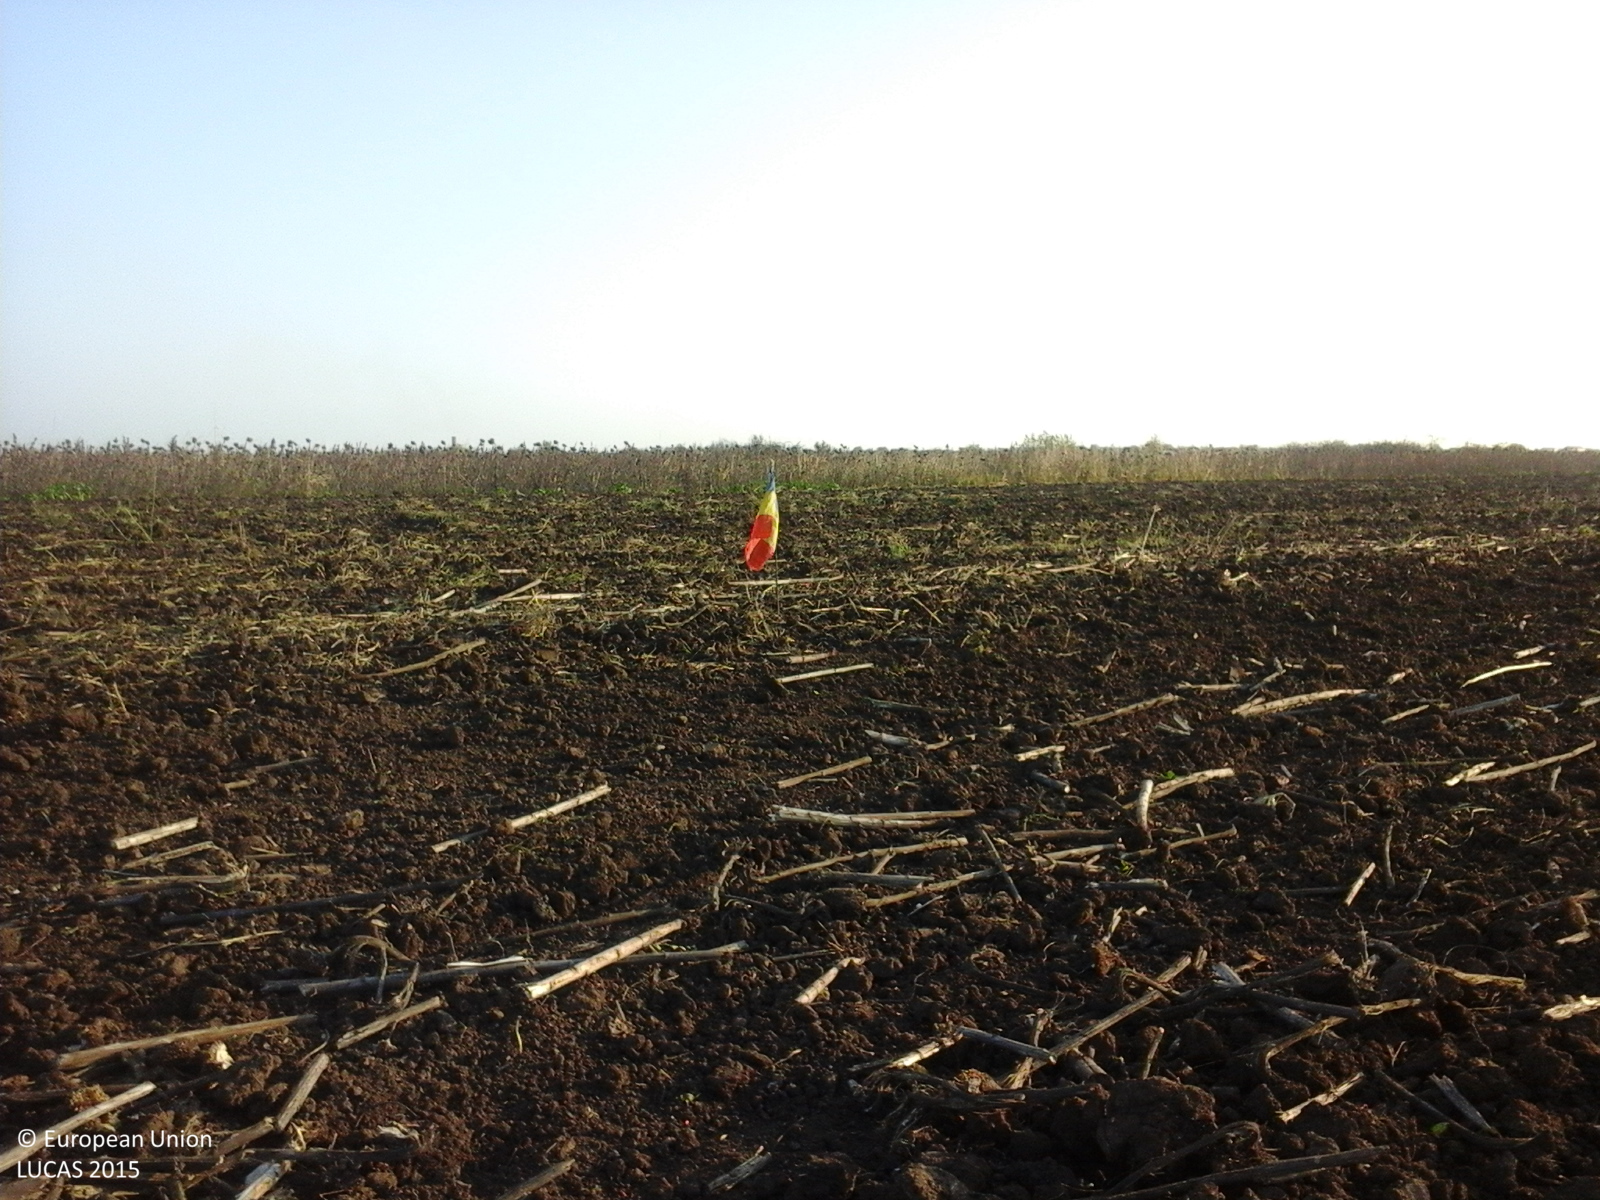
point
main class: Cropland
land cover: Sunflower
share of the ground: < 10 %
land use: Agriculture (excluding fallow land and kitchen gardens)
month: October
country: RO
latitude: 45.1574
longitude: 26.9120
